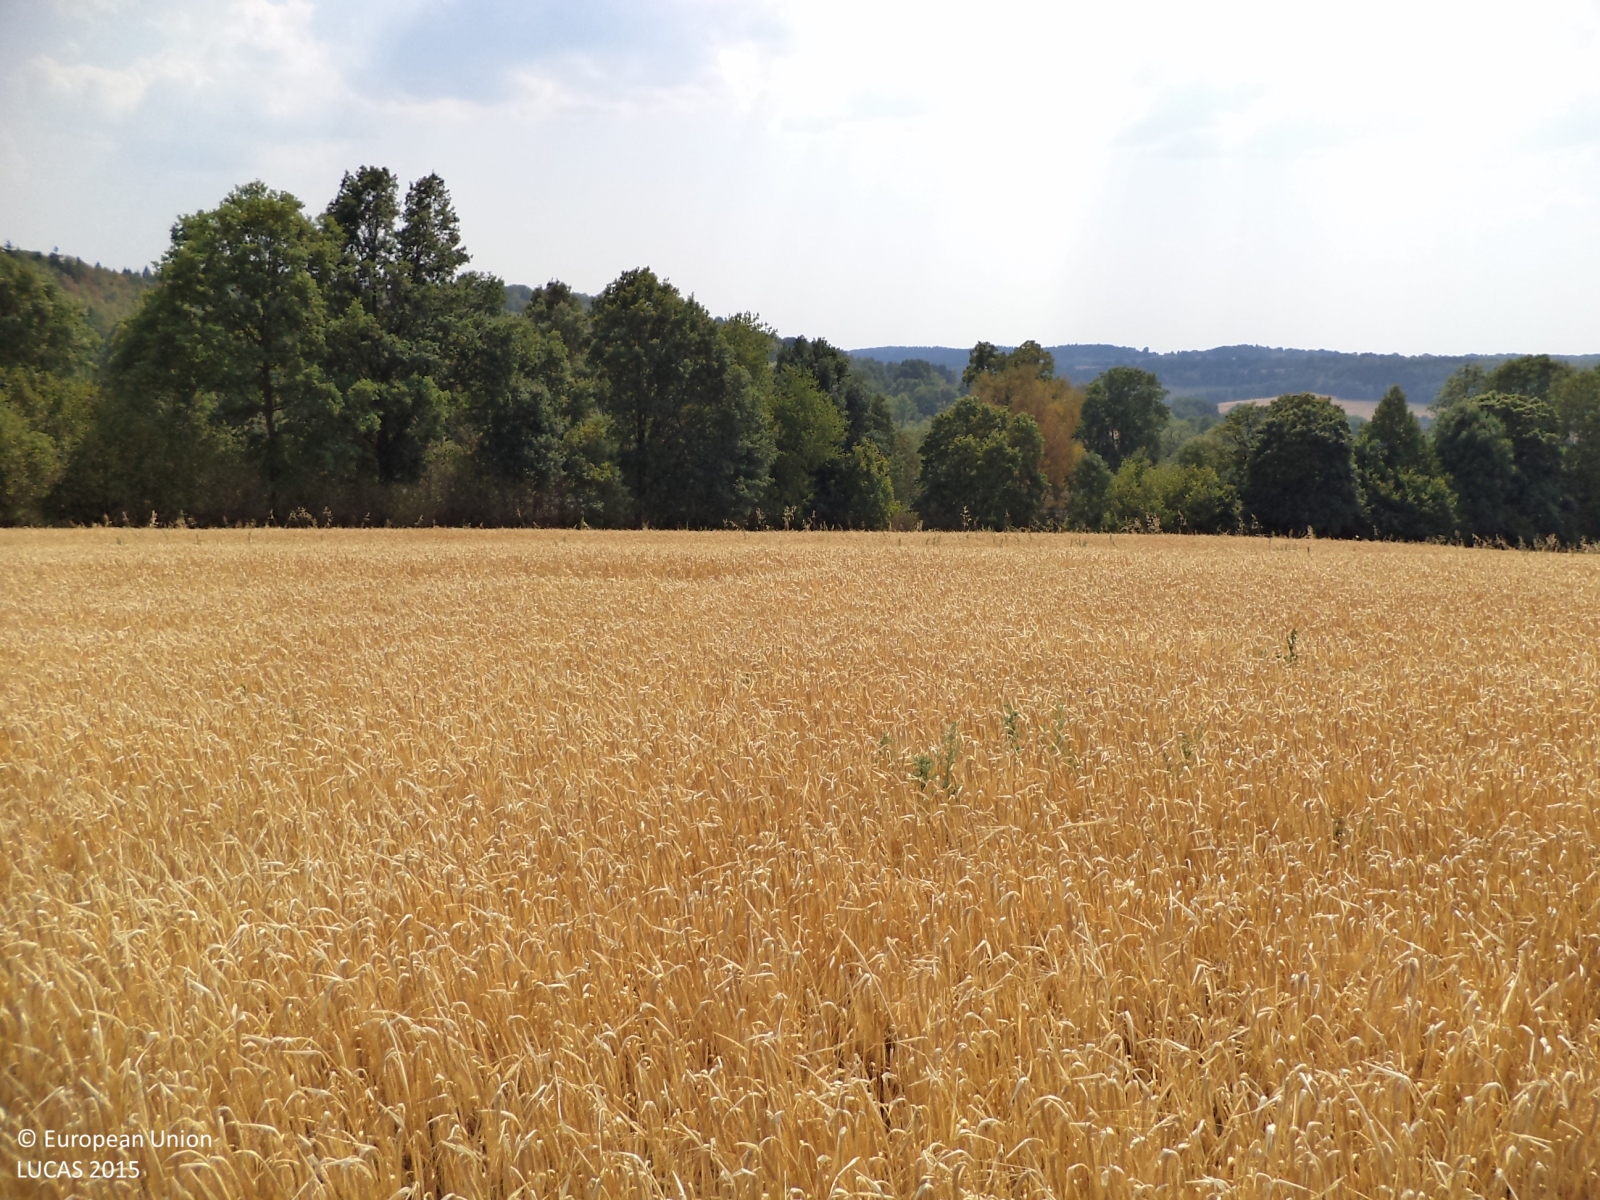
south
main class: Cropland
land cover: Barley
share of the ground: > 75 %
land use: Agriculture (excluding fallow land and kitchen gardens)
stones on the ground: < 10 %
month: August
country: CZ
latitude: 49.5037
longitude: 14.4340
